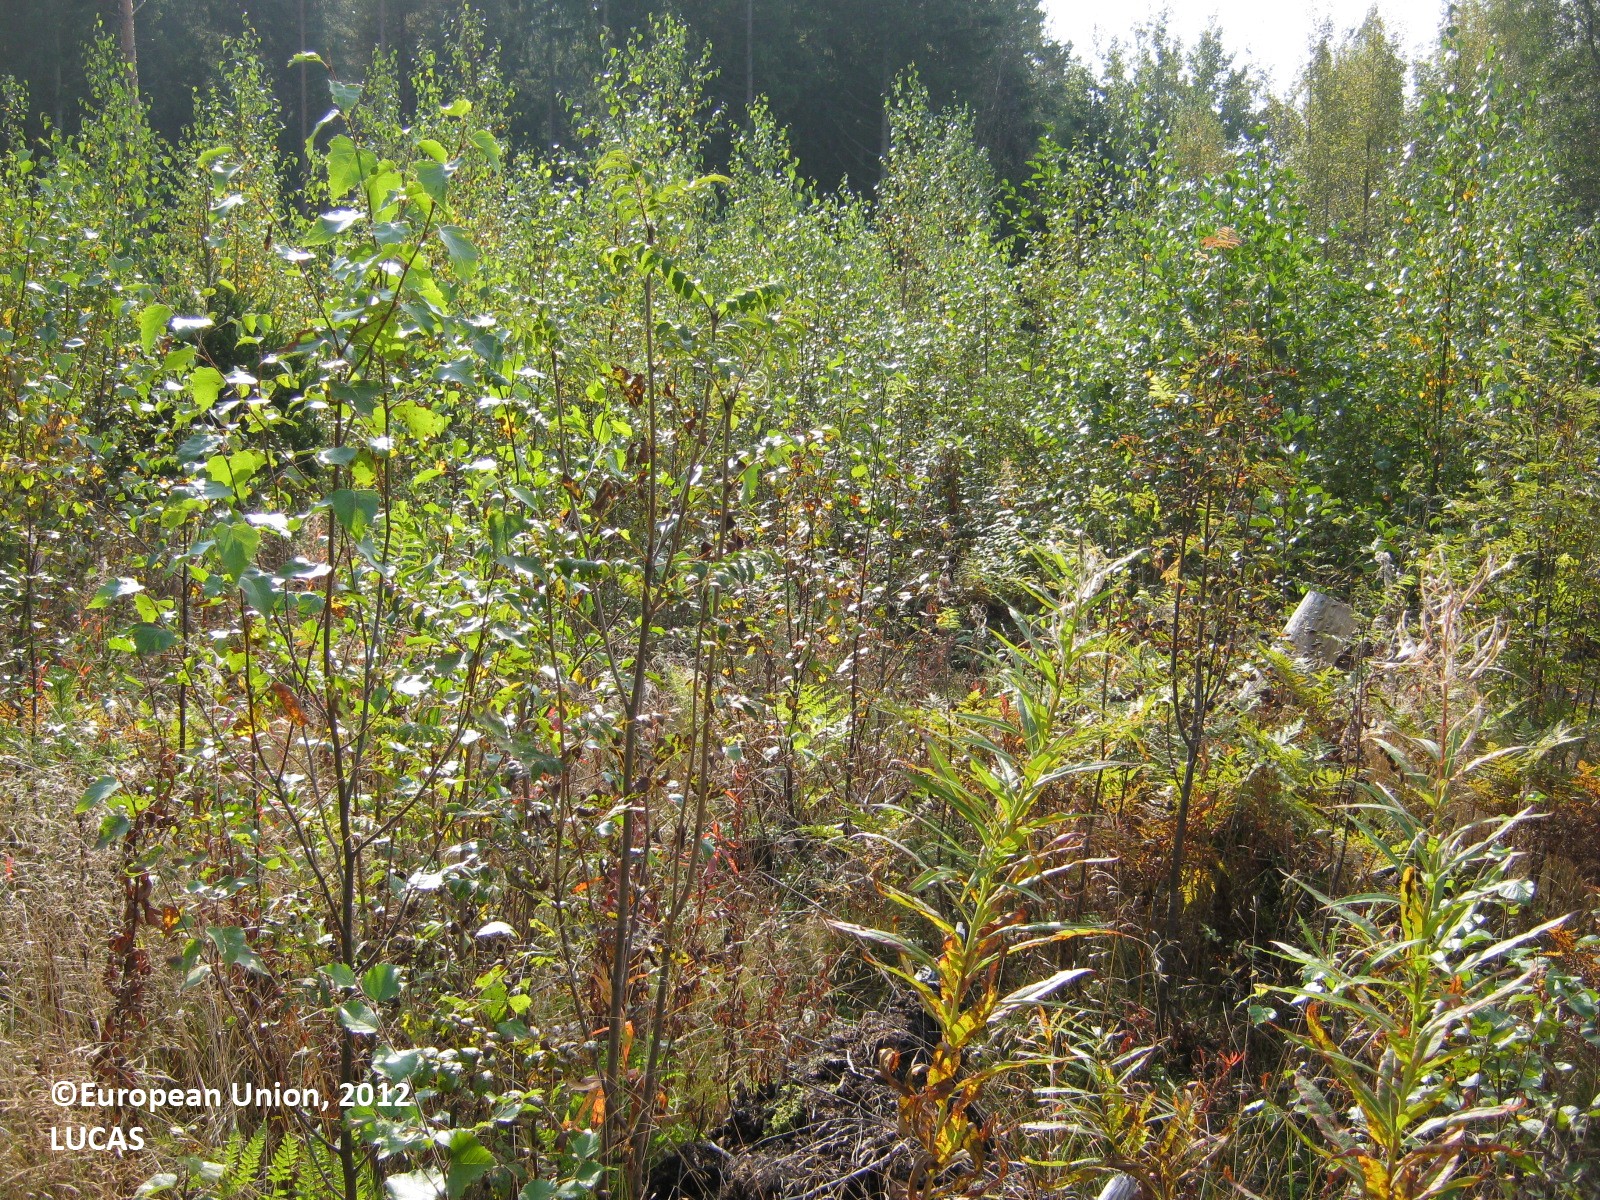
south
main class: Woodland
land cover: Broadleaved woodland
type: boreal forest
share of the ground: 25 - 50 %
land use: Forestry
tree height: < 5 m
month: September
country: FI
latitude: 60.5285
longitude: 27.7039
